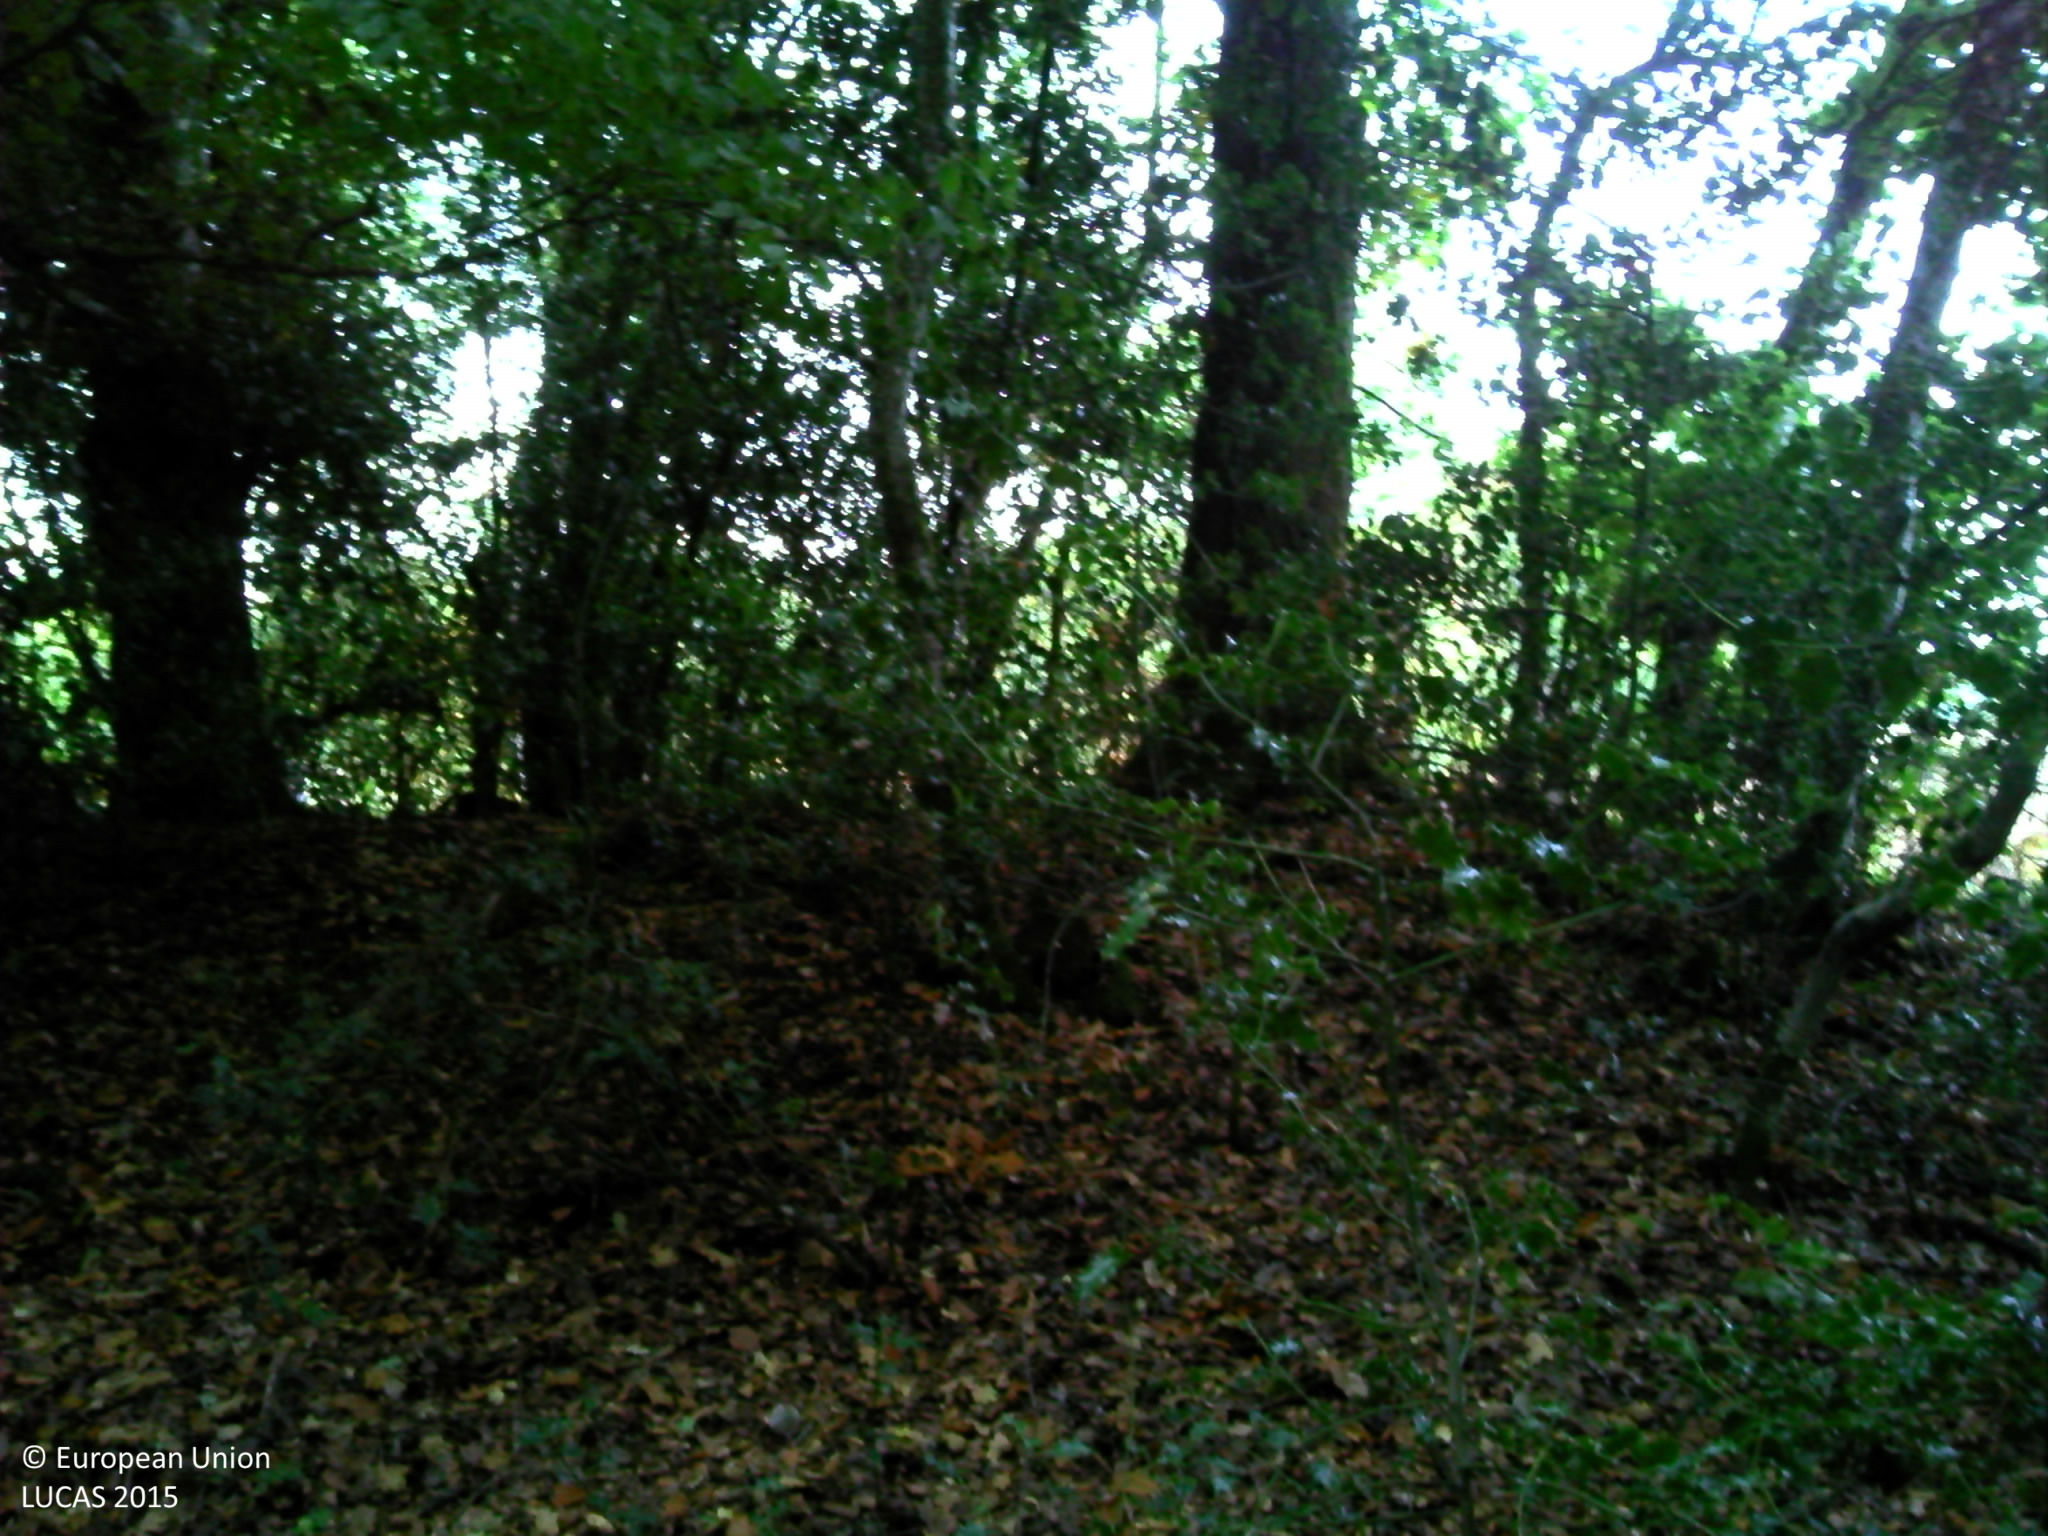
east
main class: Woodland
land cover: Broadleaved woodland
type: beech forest
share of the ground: > 75 %
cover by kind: broadleaved forest trees 85 %, herbaceous plants 15 %
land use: Forestry
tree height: > 5 m
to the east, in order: Broadleaved woodland; Other bare soil; Broadleaved woodland; Other bare soil
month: October
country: FR
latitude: 45.9124
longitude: 2.8433
